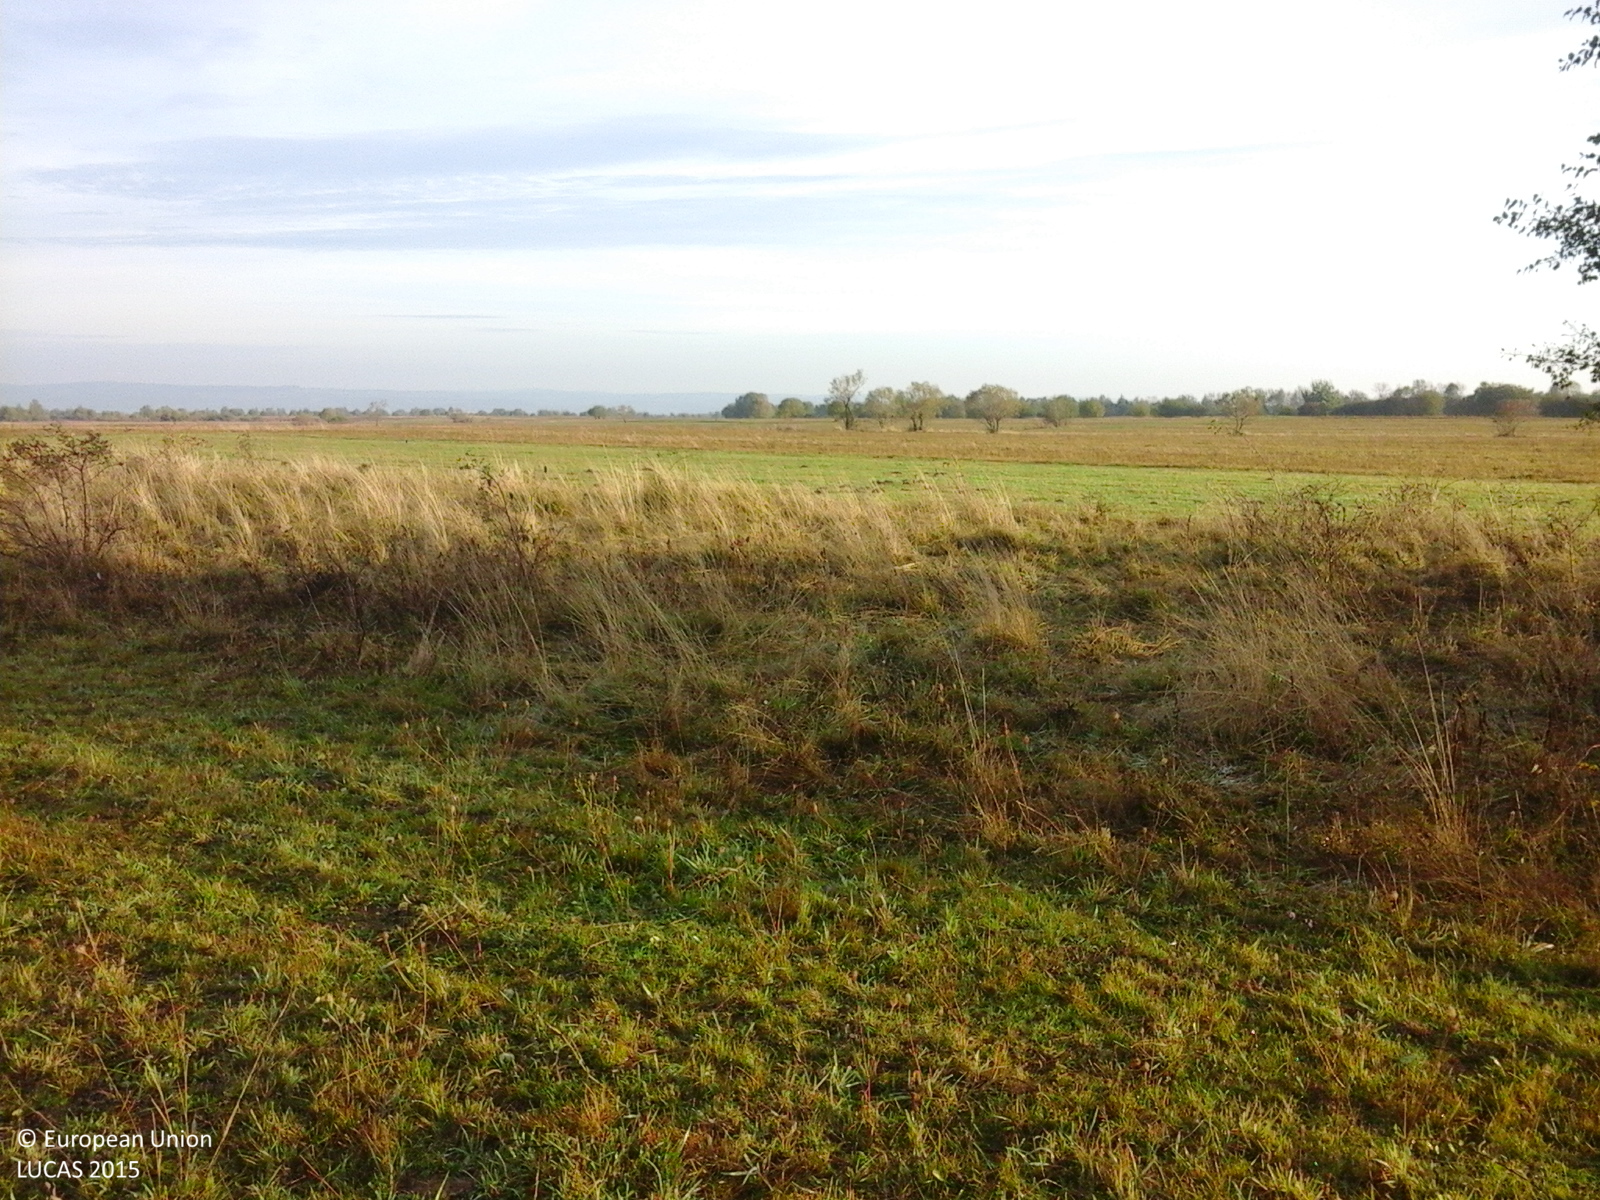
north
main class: Grassland
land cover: Grassland without tree/shrub cover
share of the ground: > 75 %
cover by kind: herbaceous plants 100 %
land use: Agriculture (excluding fallow land and kitchen gardens)
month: October
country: RO
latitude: 45.7380
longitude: 25.0393
